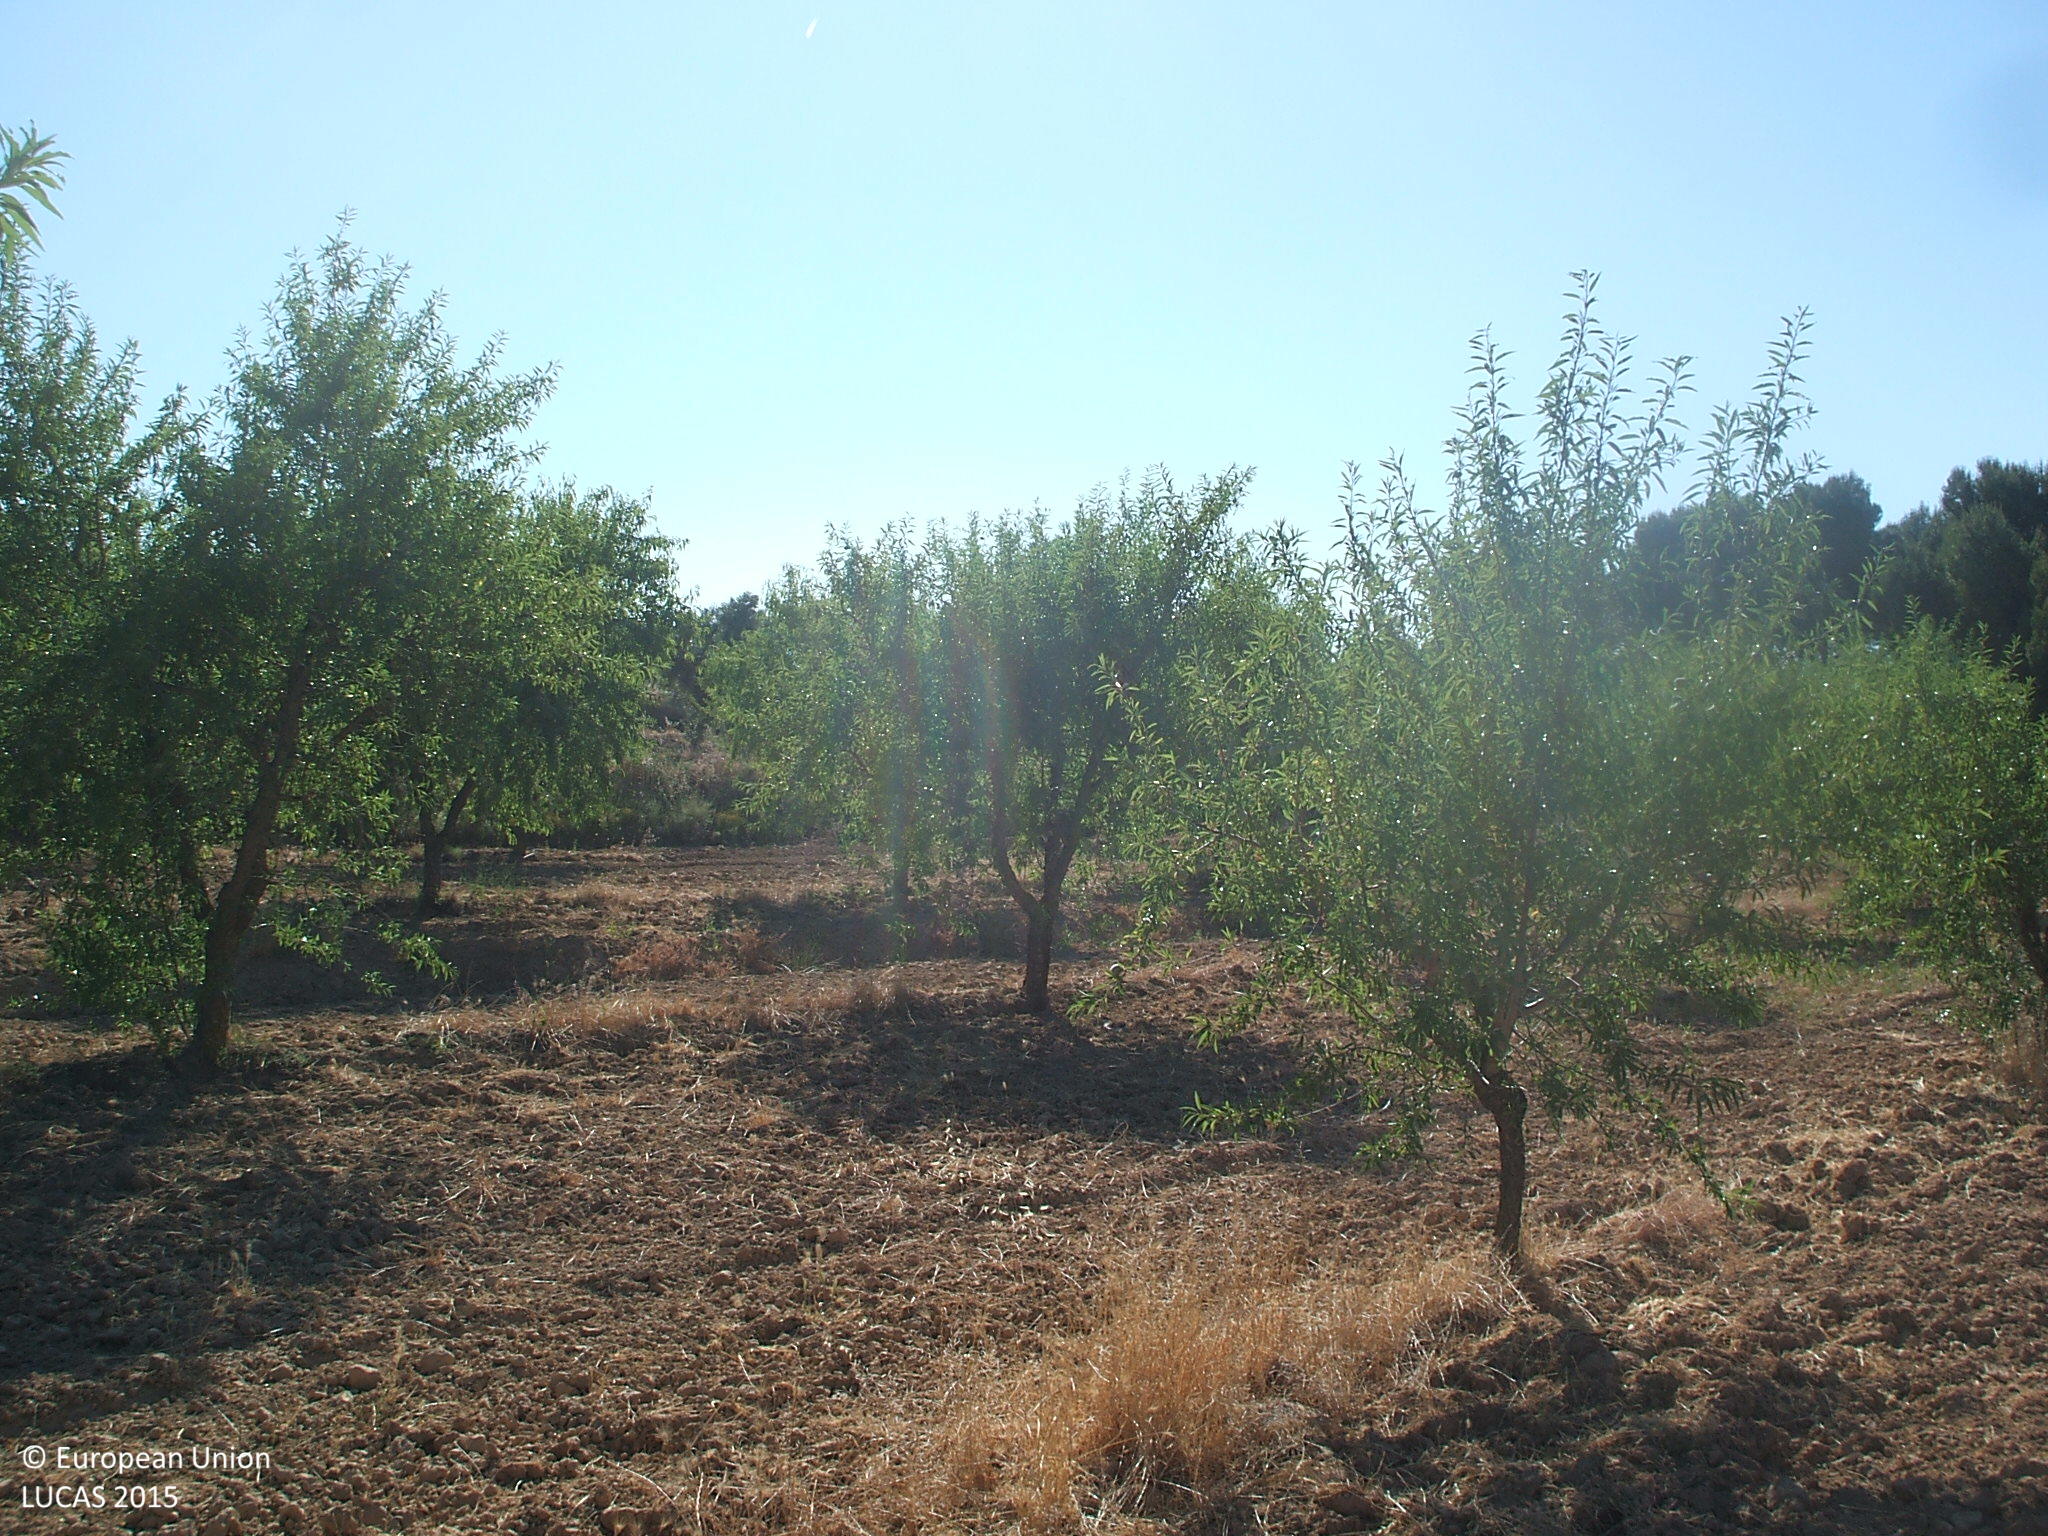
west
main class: Shrubland
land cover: Shrubland without tree cover
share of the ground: > 75 %
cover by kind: shrubs 100 %
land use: Agriculture (excluding fallow land and kitchen gardens)
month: June
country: ES
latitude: 41.0296
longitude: 0.1780
